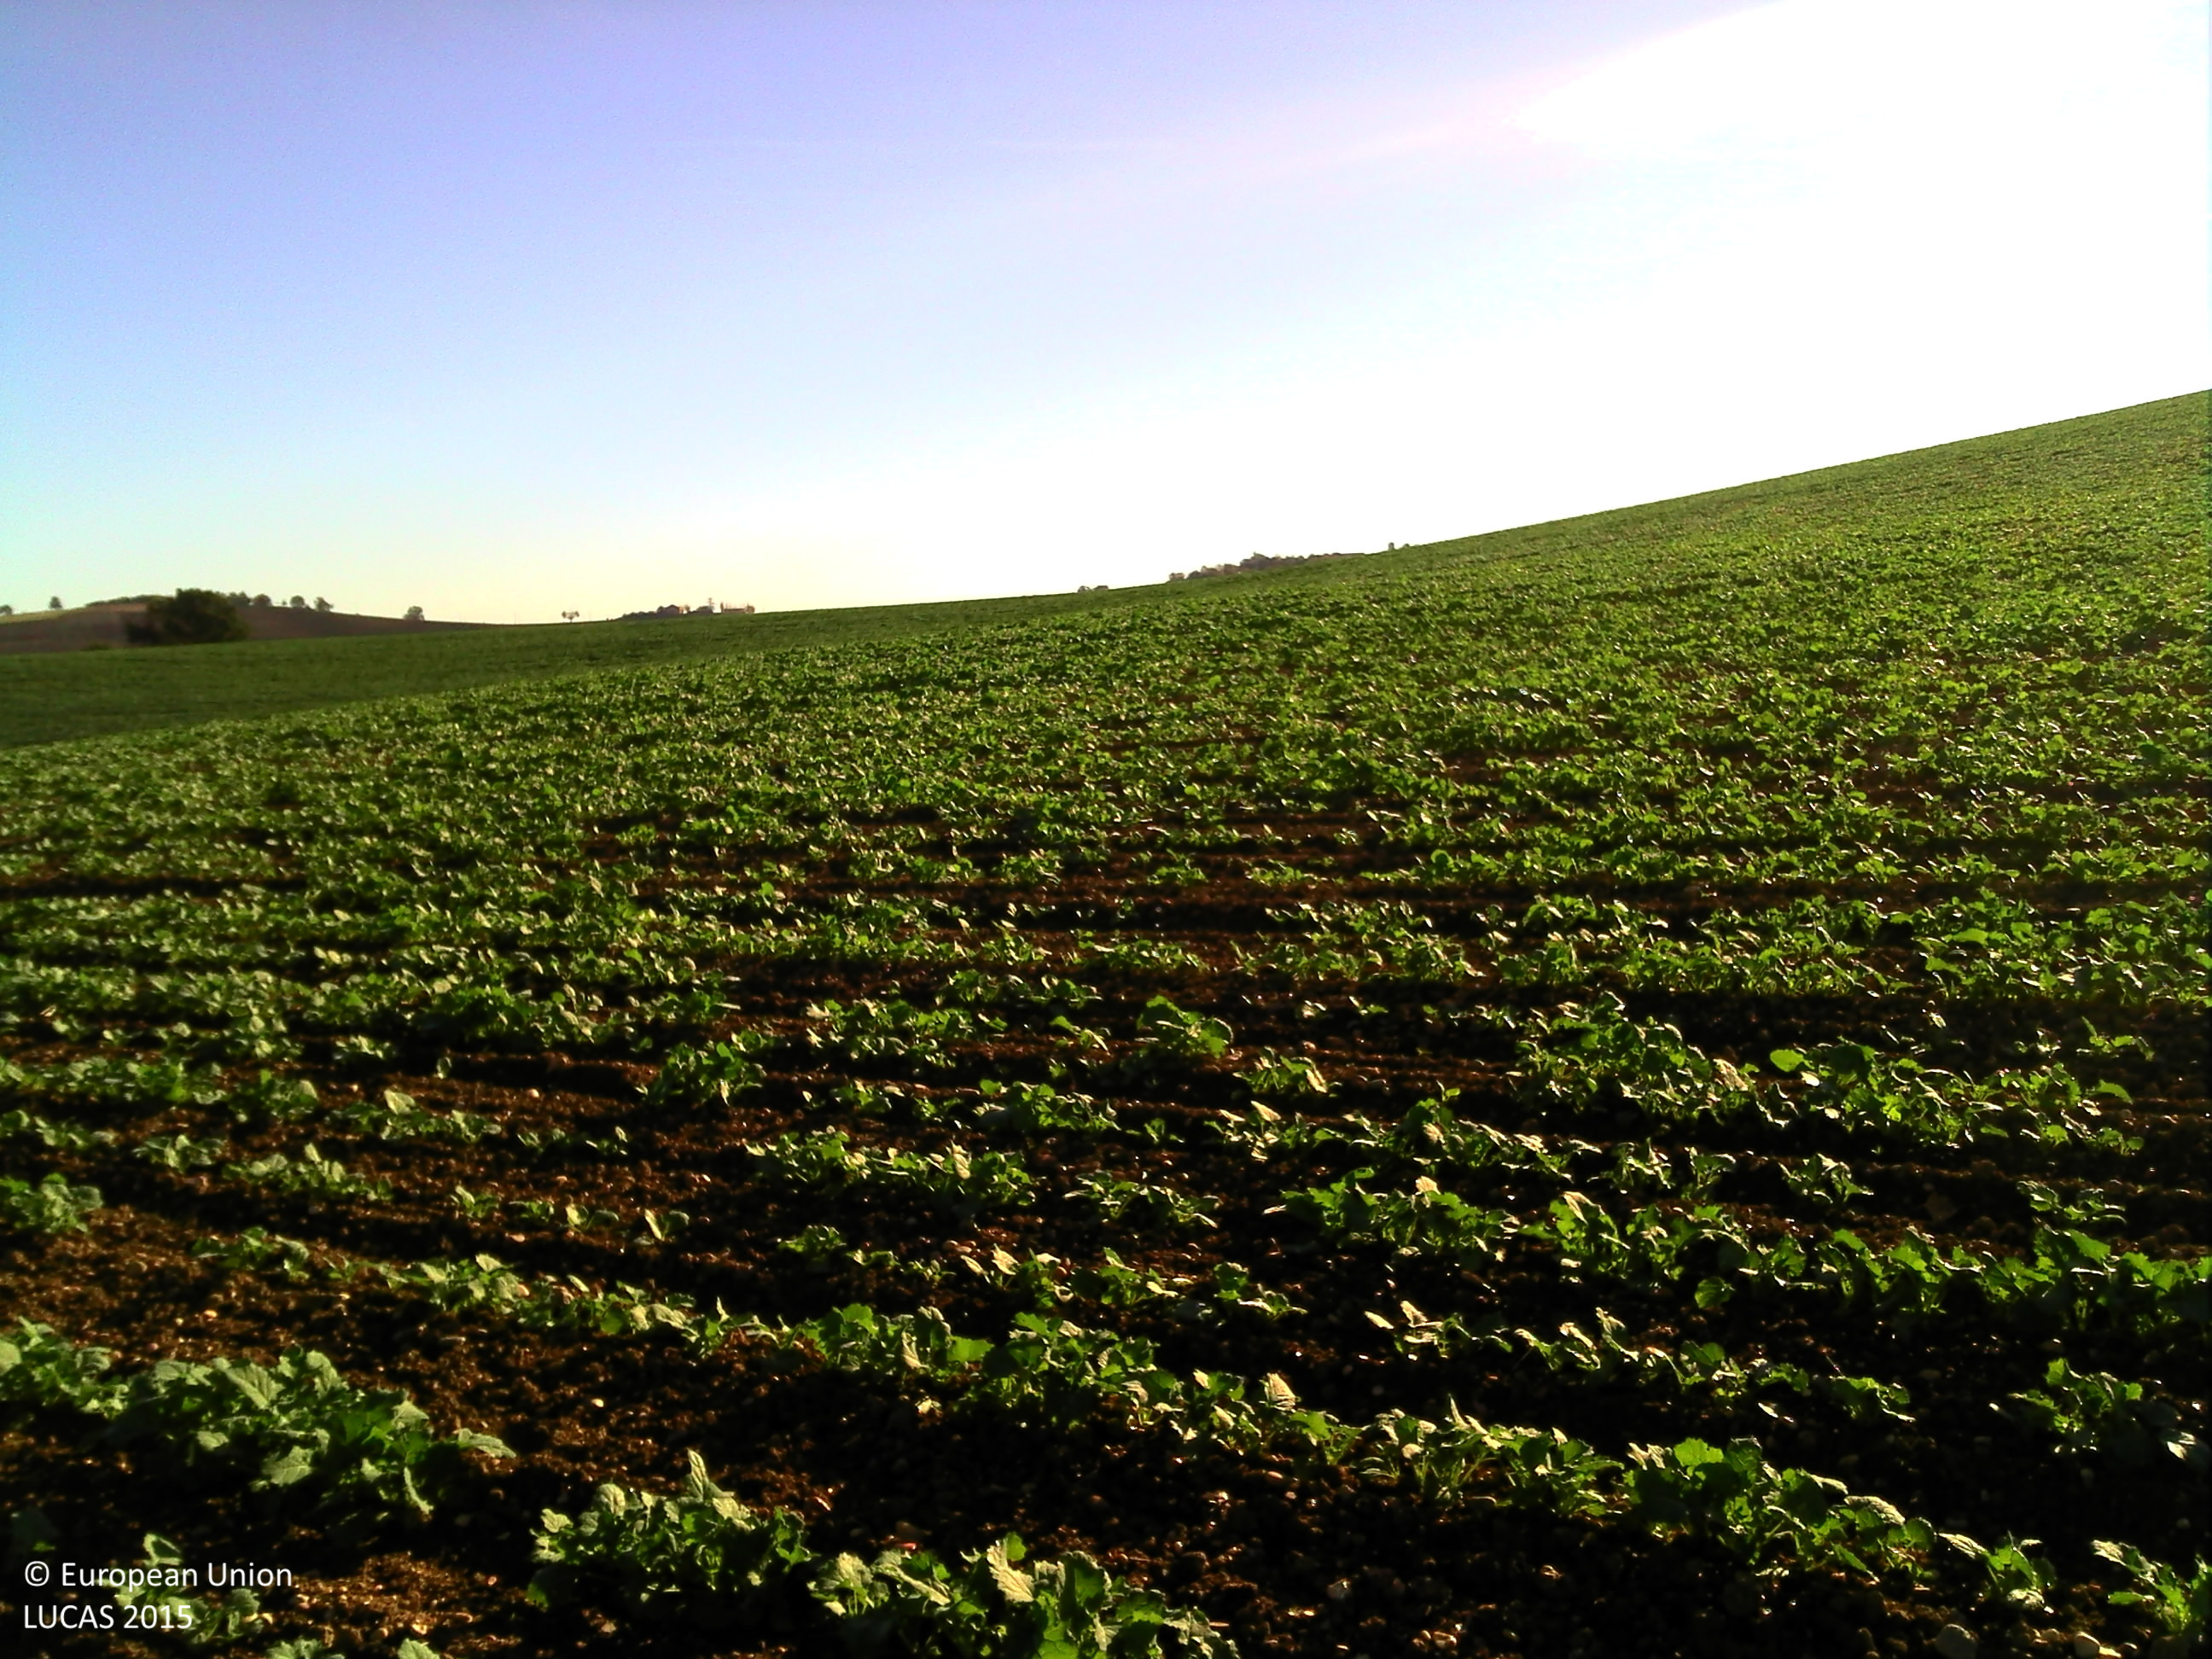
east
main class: Cropland
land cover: Rape and turnip rape
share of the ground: 25 - 50 %
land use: Agriculture (excluding fallow land and kitchen gardens)
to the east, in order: Rape and turnip rape
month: October
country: FR
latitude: 43.9556
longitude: 0.9635
